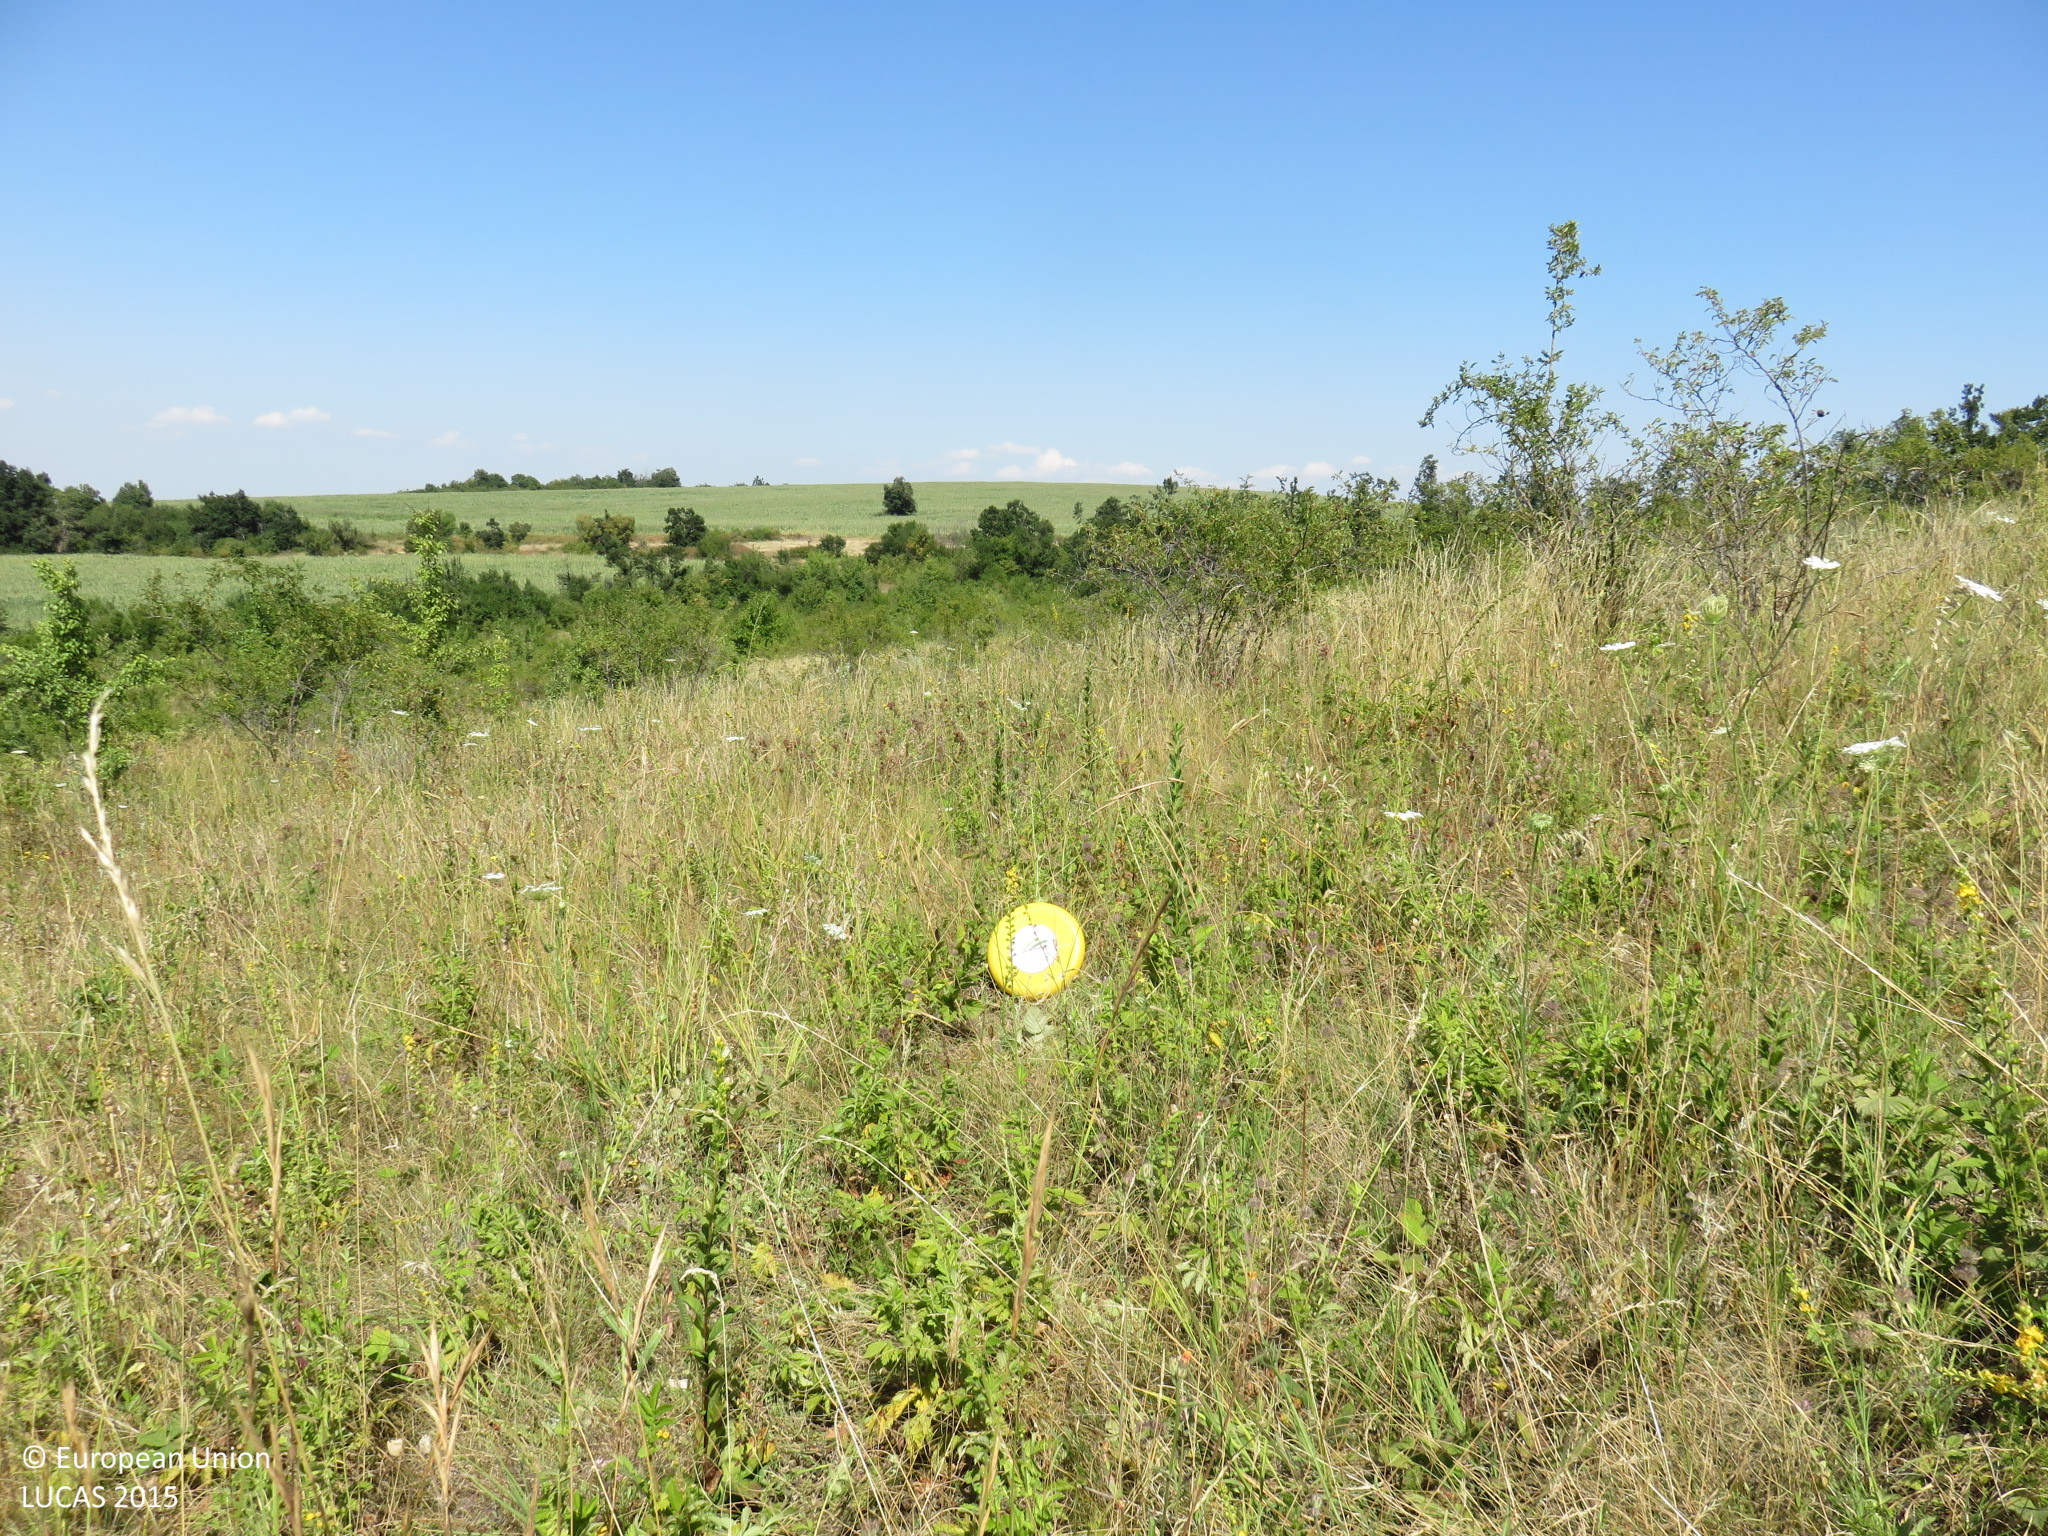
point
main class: Shrubland
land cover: Shrubland with sparse tree cover
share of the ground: > 75 %
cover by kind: shrubs 75 %, herbaceous plants 20 %, broadleaved forest trees 5 %
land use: Semi-natural and natural areas not in use
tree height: < 5 m
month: July
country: BG
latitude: 43.2198
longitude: 24.9760
